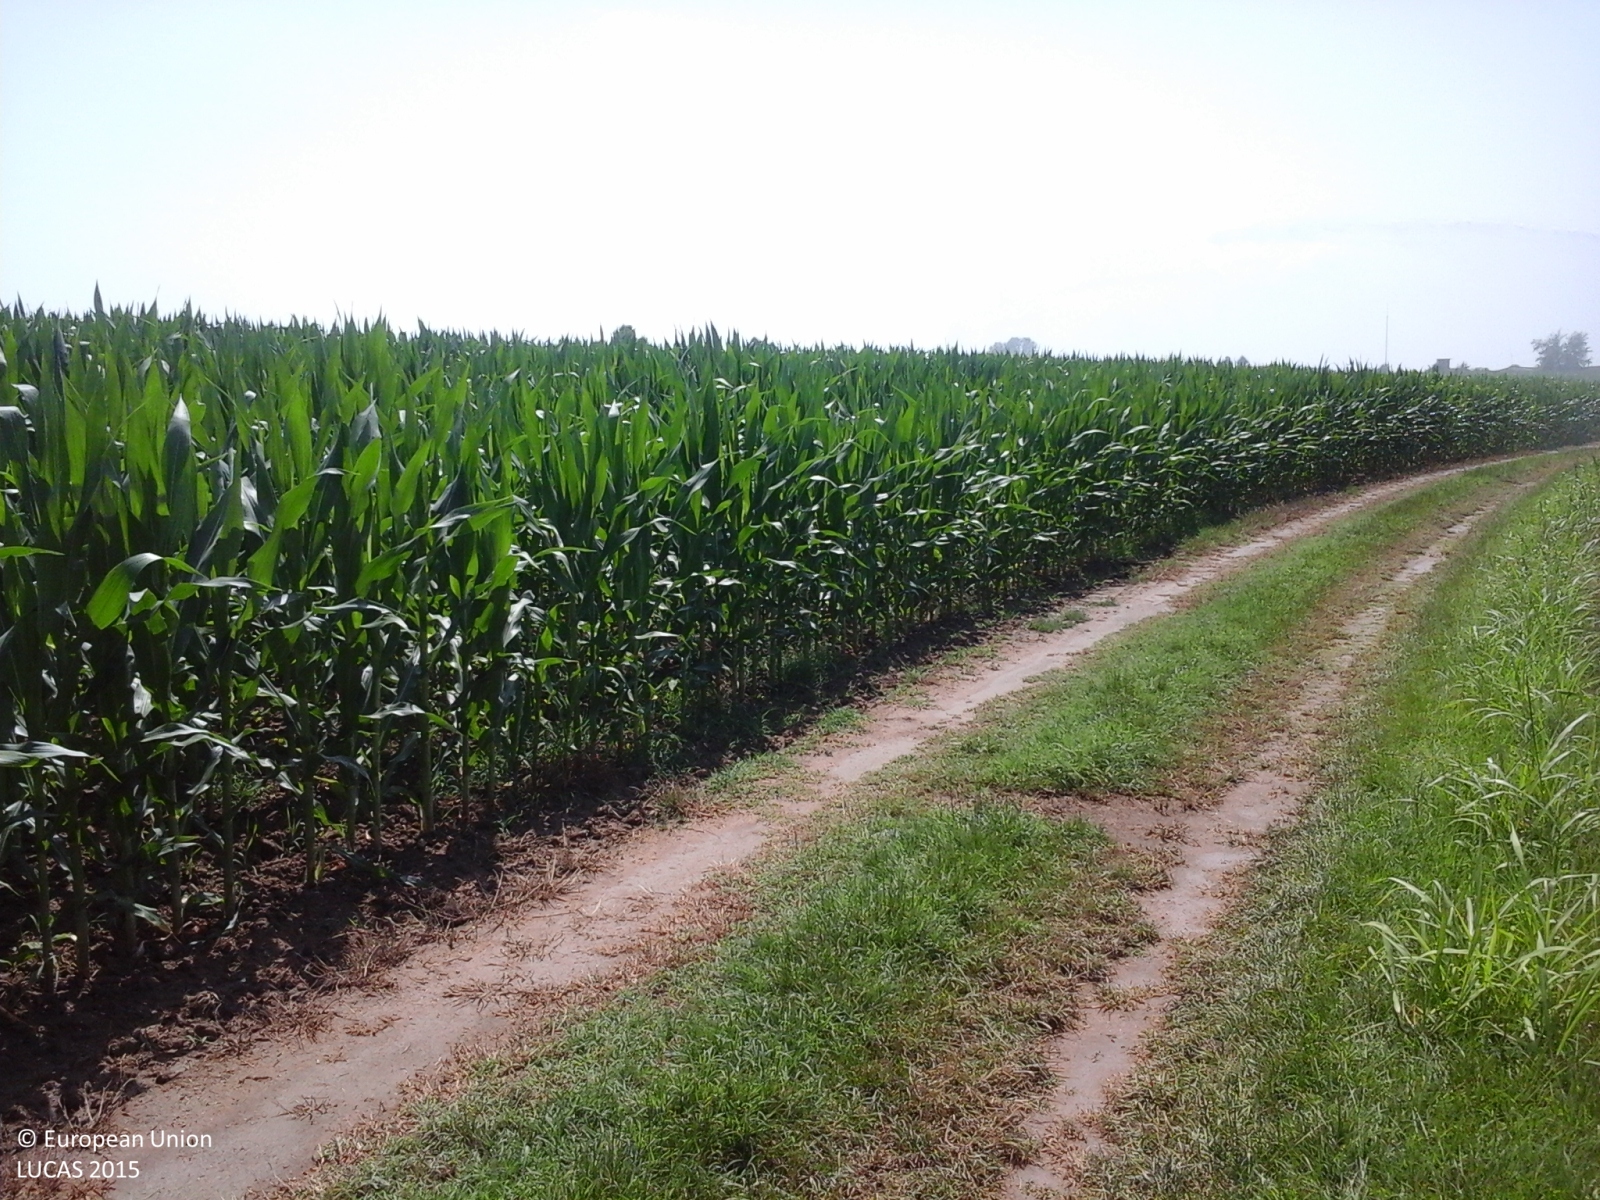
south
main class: Cropland
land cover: Maize
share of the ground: > 75 %
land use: Agriculture (excluding fallow land and kitchen gardens)
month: June
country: IT
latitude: 45.2463
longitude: 11.1064
